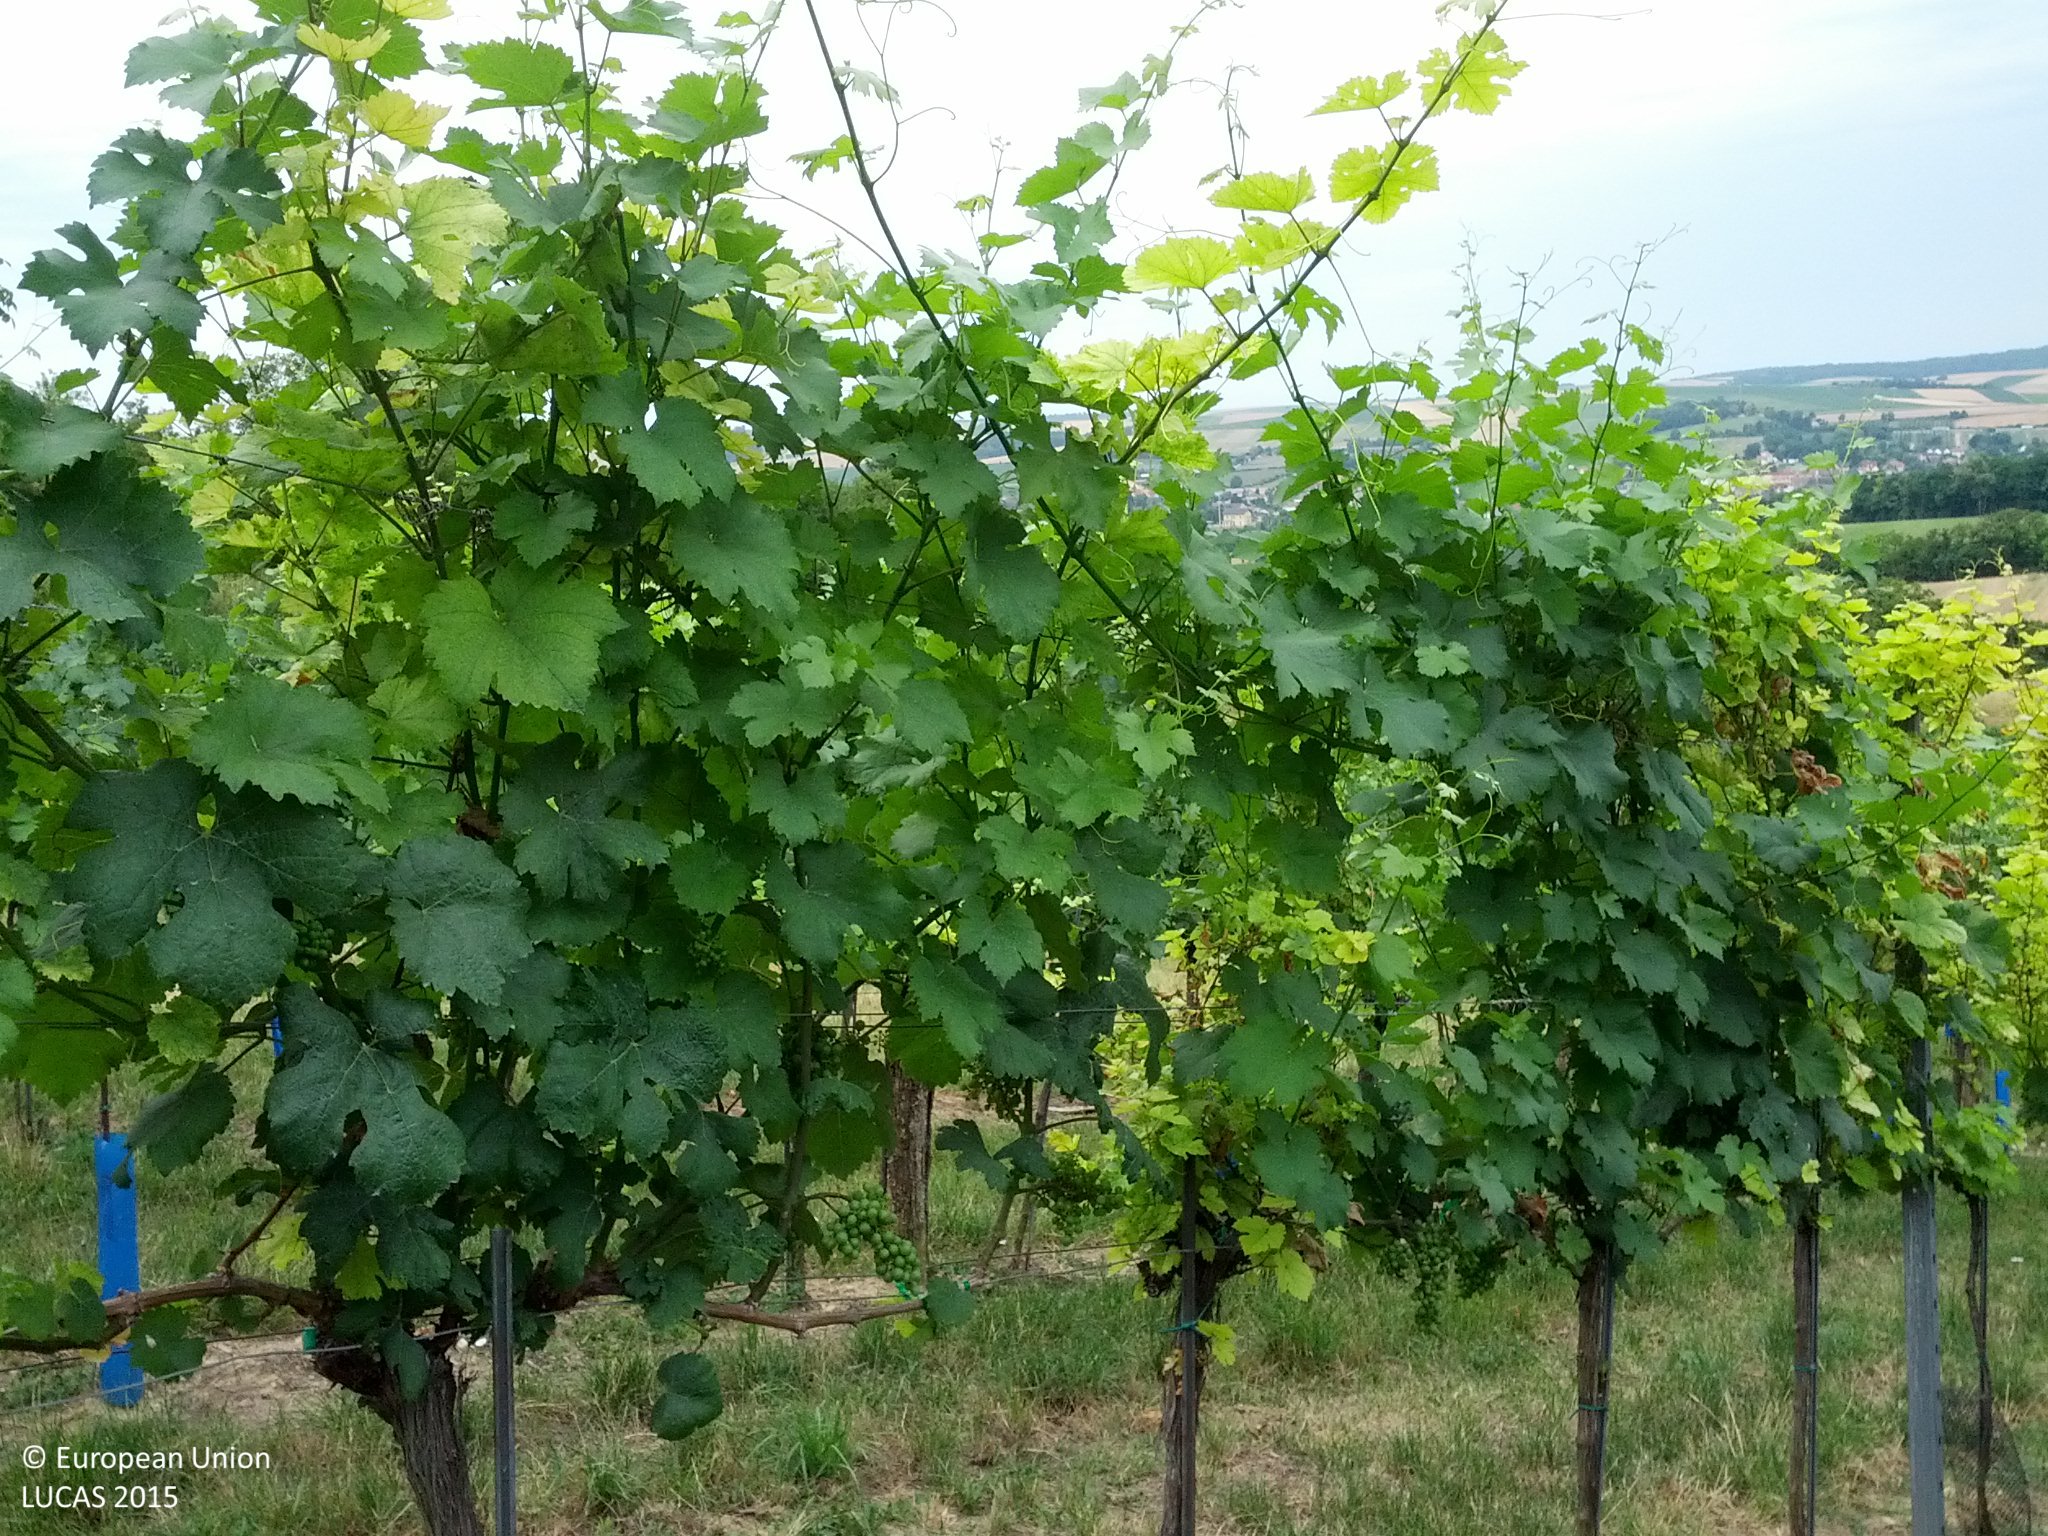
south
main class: Cropland
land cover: Vineyards
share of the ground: 50 - 75 %
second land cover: Grassland without tree/shrub cover
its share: 50 - 75 %
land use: Agriculture (excluding fallow land and kitchen gardens)
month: July
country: AT
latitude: 48.5037
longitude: 16.1359
